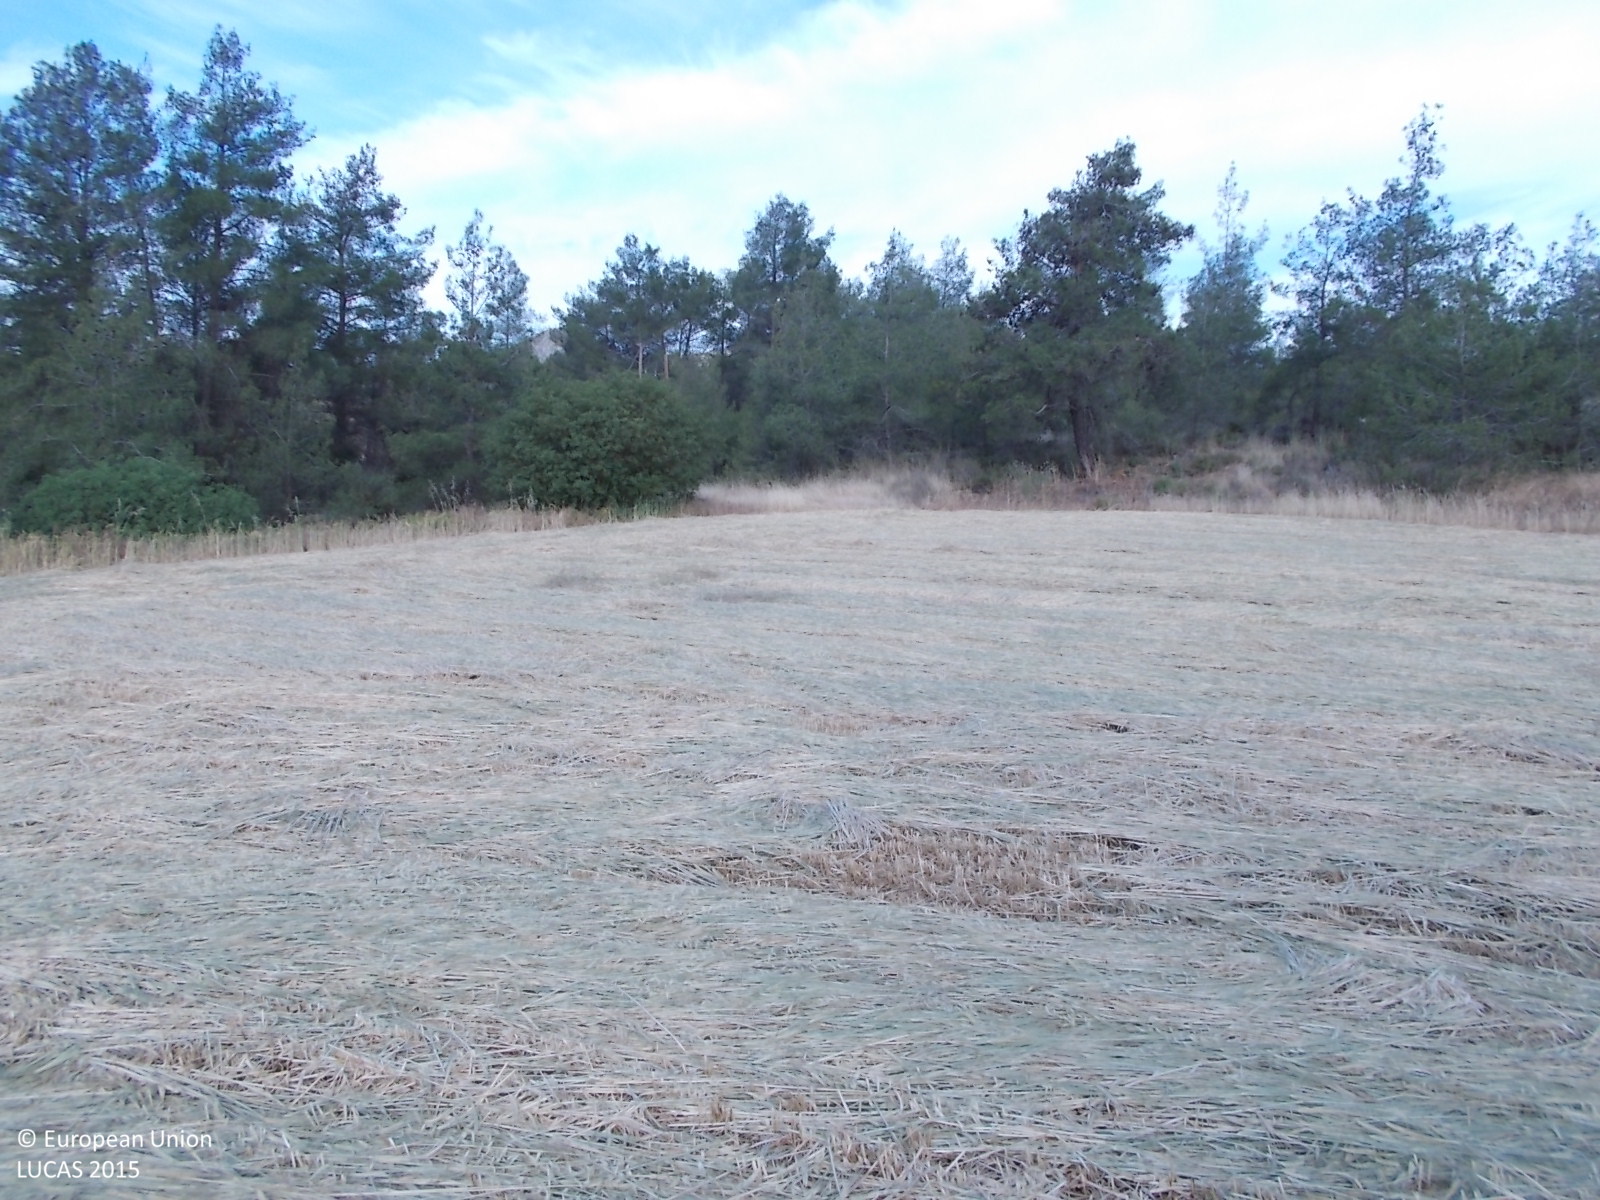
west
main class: Cropland
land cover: Mixed cereals for fodder
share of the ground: > 75 %
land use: Agriculture (excluding fallow land and kitchen gardens)
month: May
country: CY
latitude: 34.9089
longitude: 33.3547
